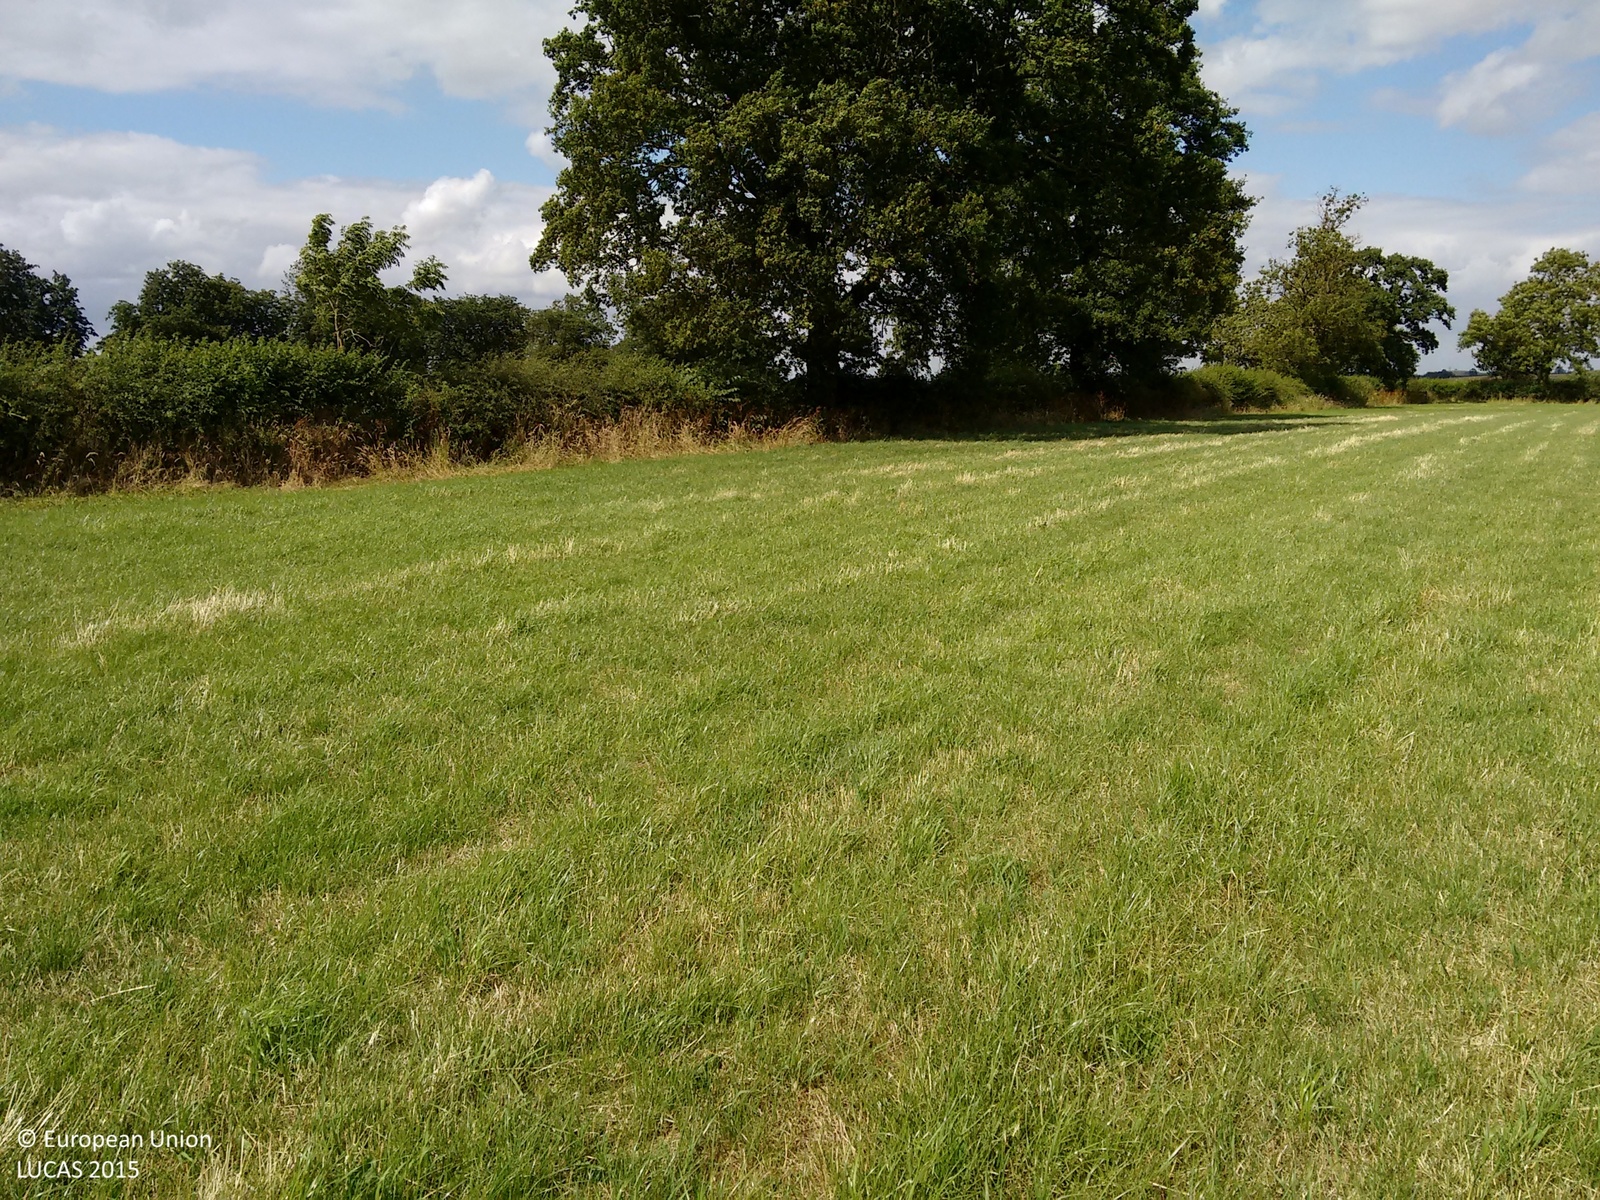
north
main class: Grassland
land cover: Grassland without tree/shrub cover
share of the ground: > 75 %
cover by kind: herbaceous plants 100 %
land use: Agriculture (excluding fallow land and kitchen gardens)
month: July
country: GB
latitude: 52.6658
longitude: -0.9710
